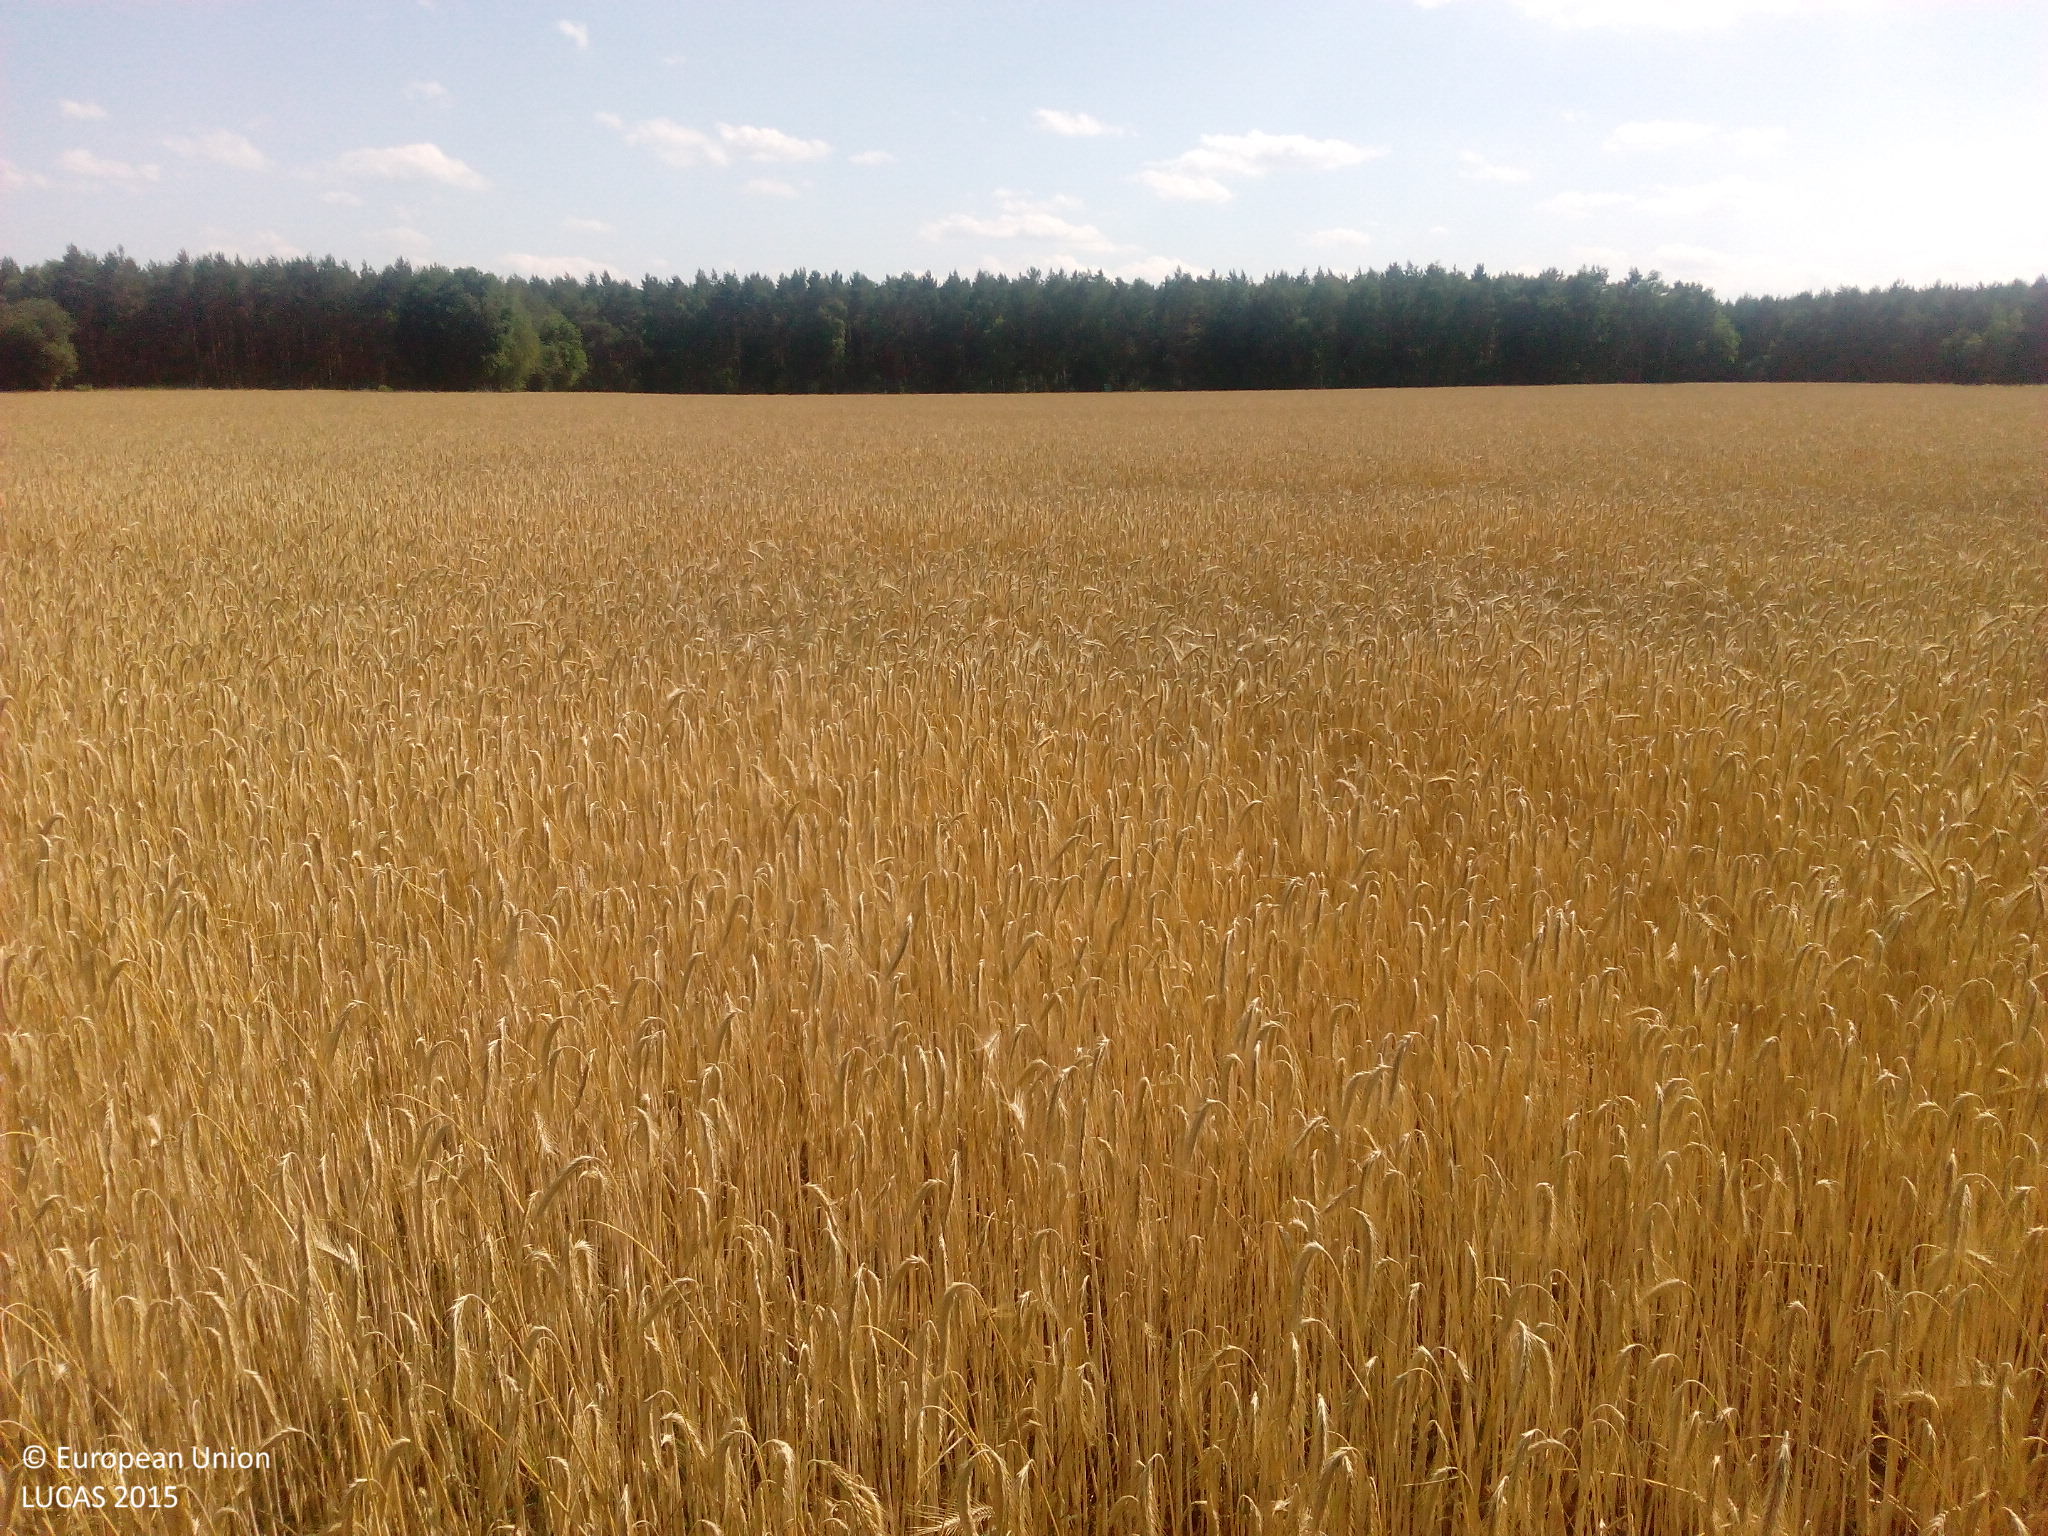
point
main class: Cropland
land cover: Rye
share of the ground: > 75 %
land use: Agriculture (excluding fallow land and kitchen gardens)
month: July
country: DE
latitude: 51.9234
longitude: 12.3117
